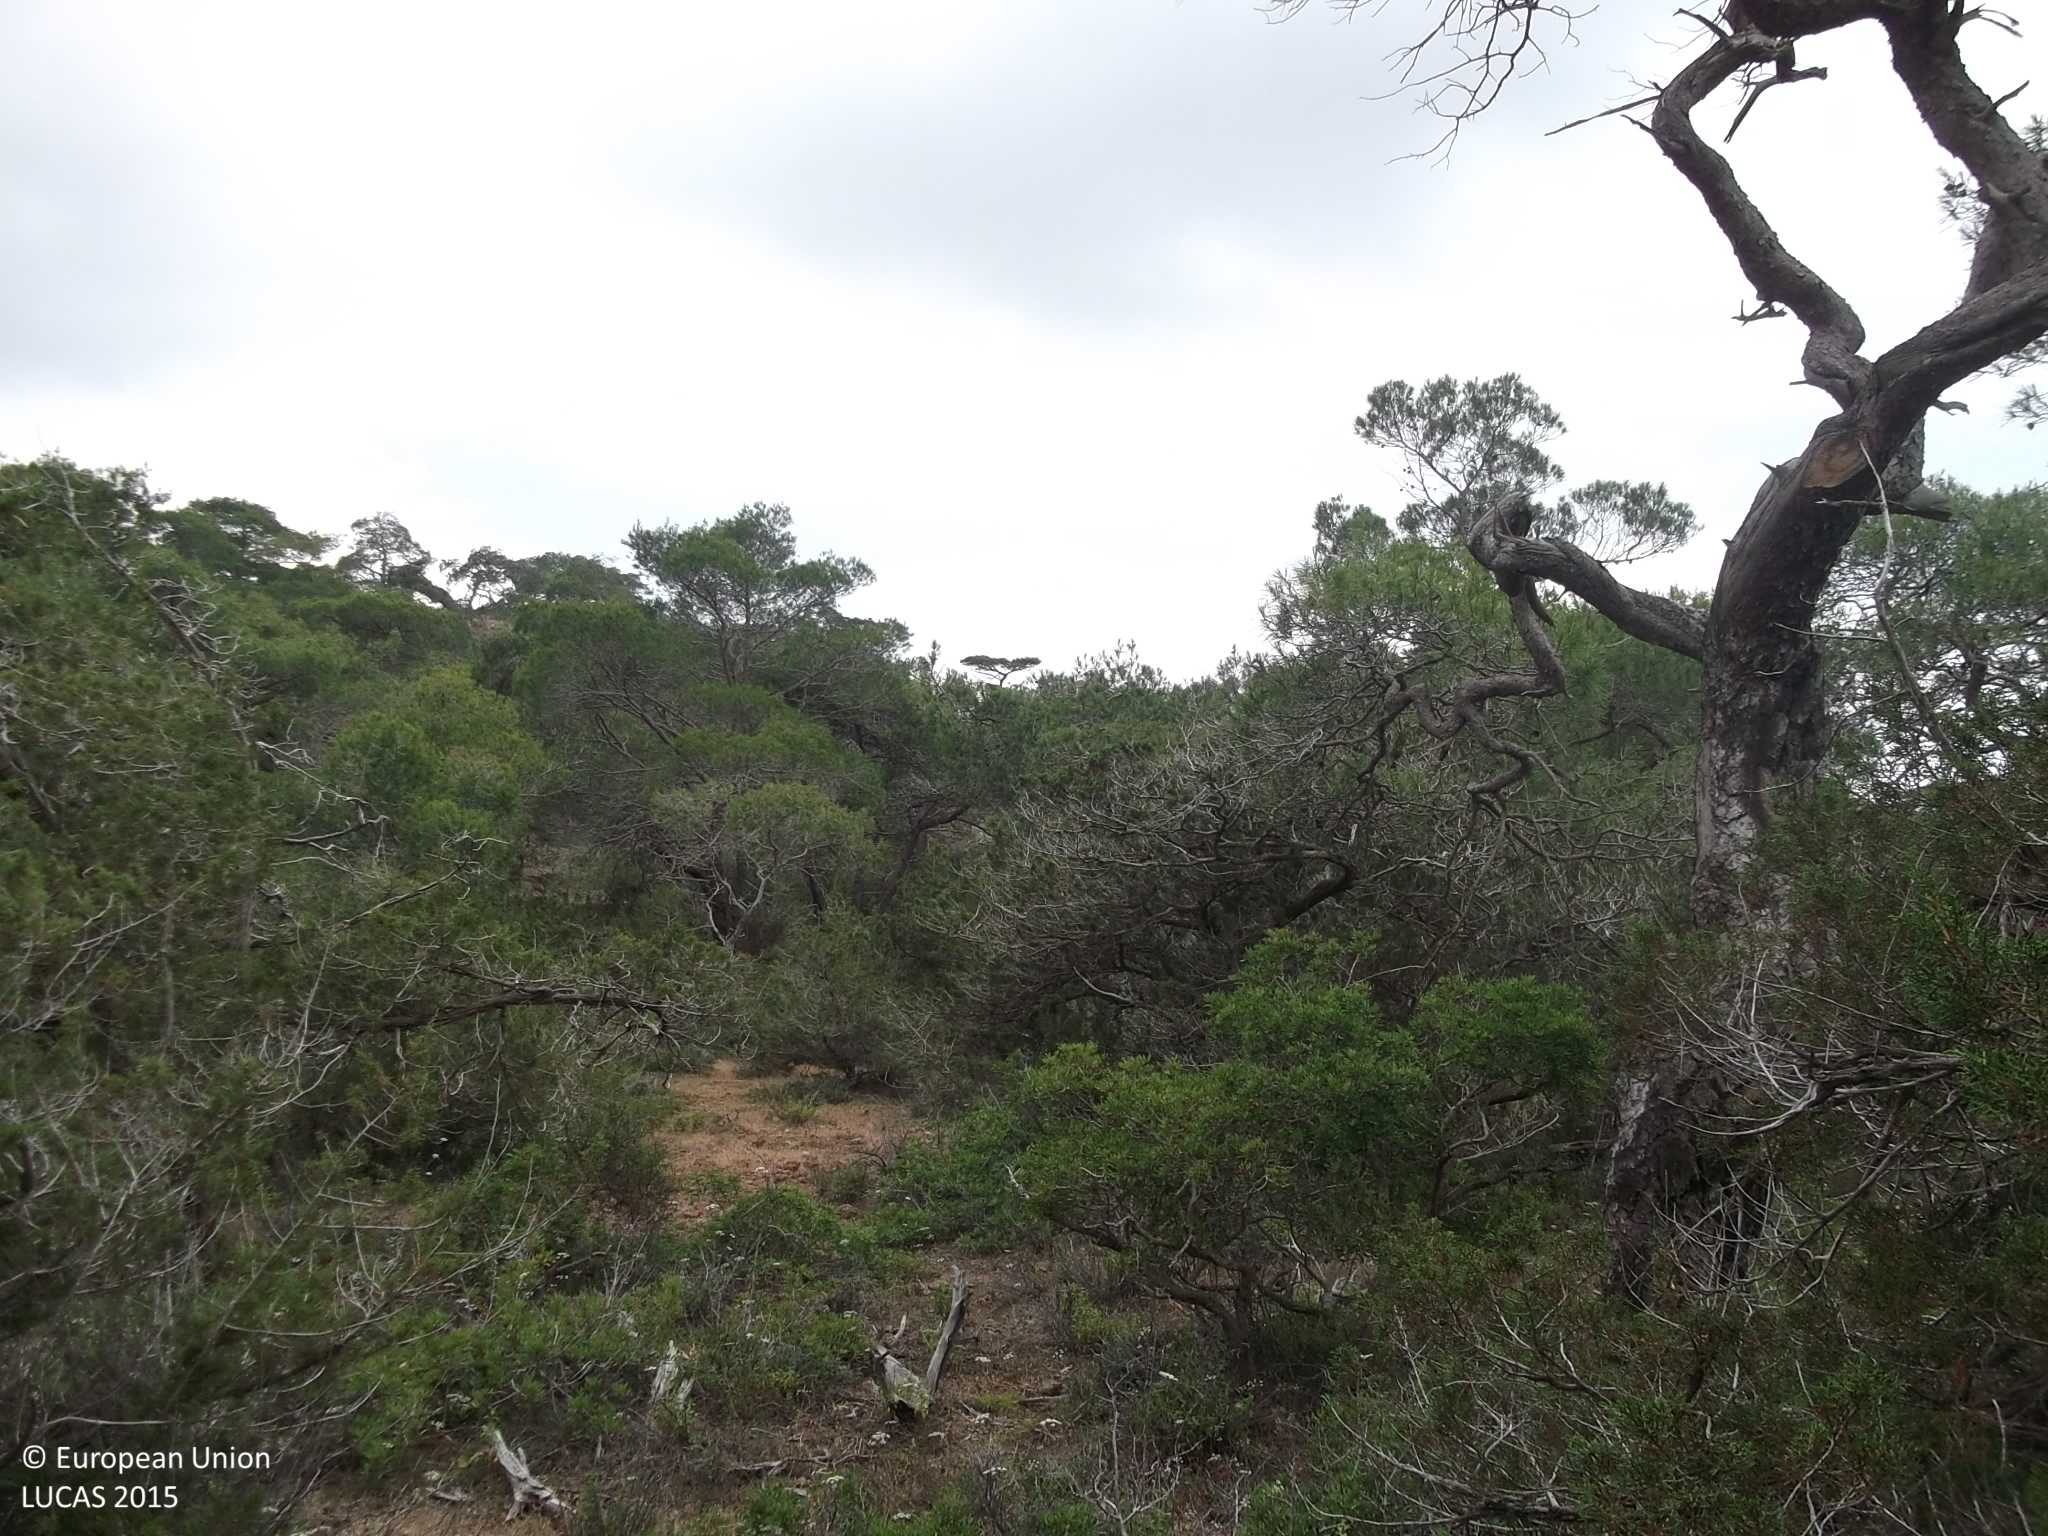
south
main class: Woodland
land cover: Other coniferous woodland
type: coniferous forest of the mediterranean region
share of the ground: > 75 %
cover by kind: coniferous forest trees 80 %, shrubs 10 %, unconsolidated bare surface 10 %
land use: Forestry
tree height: > 5 m
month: May
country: CY
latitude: 35.0385
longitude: 32.3257
